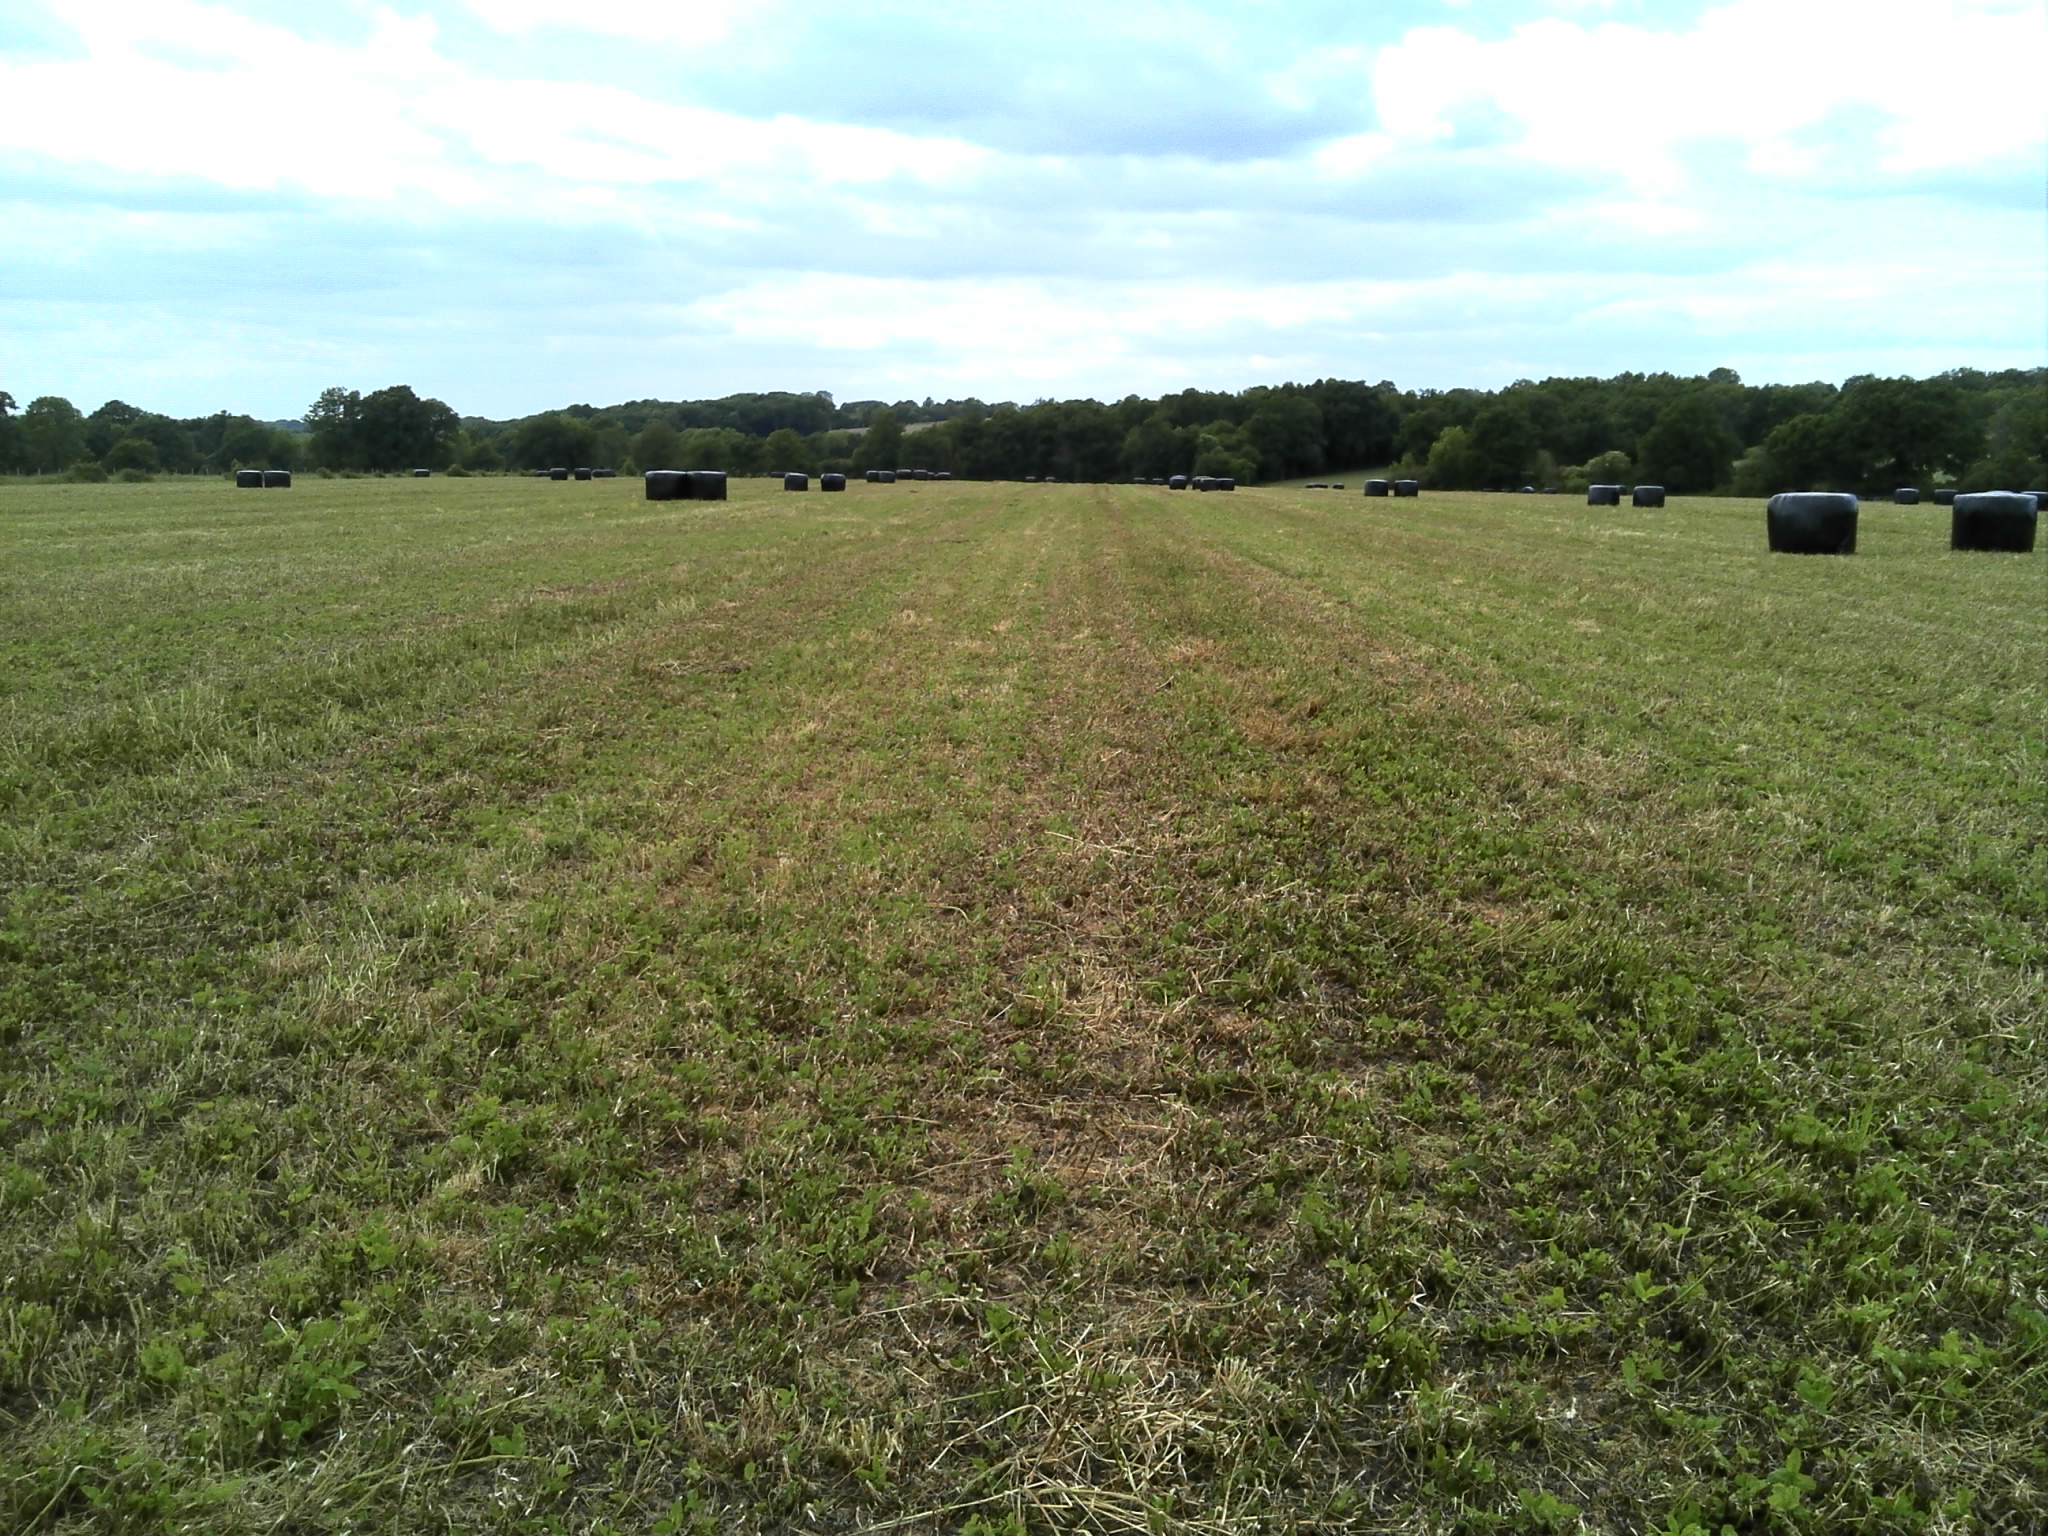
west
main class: Cropland
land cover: Clovers
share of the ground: > 75 %
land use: Agriculture (excluding fallow land and kitchen gardens)
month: May
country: FR
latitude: 46.5375
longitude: 1.5010
